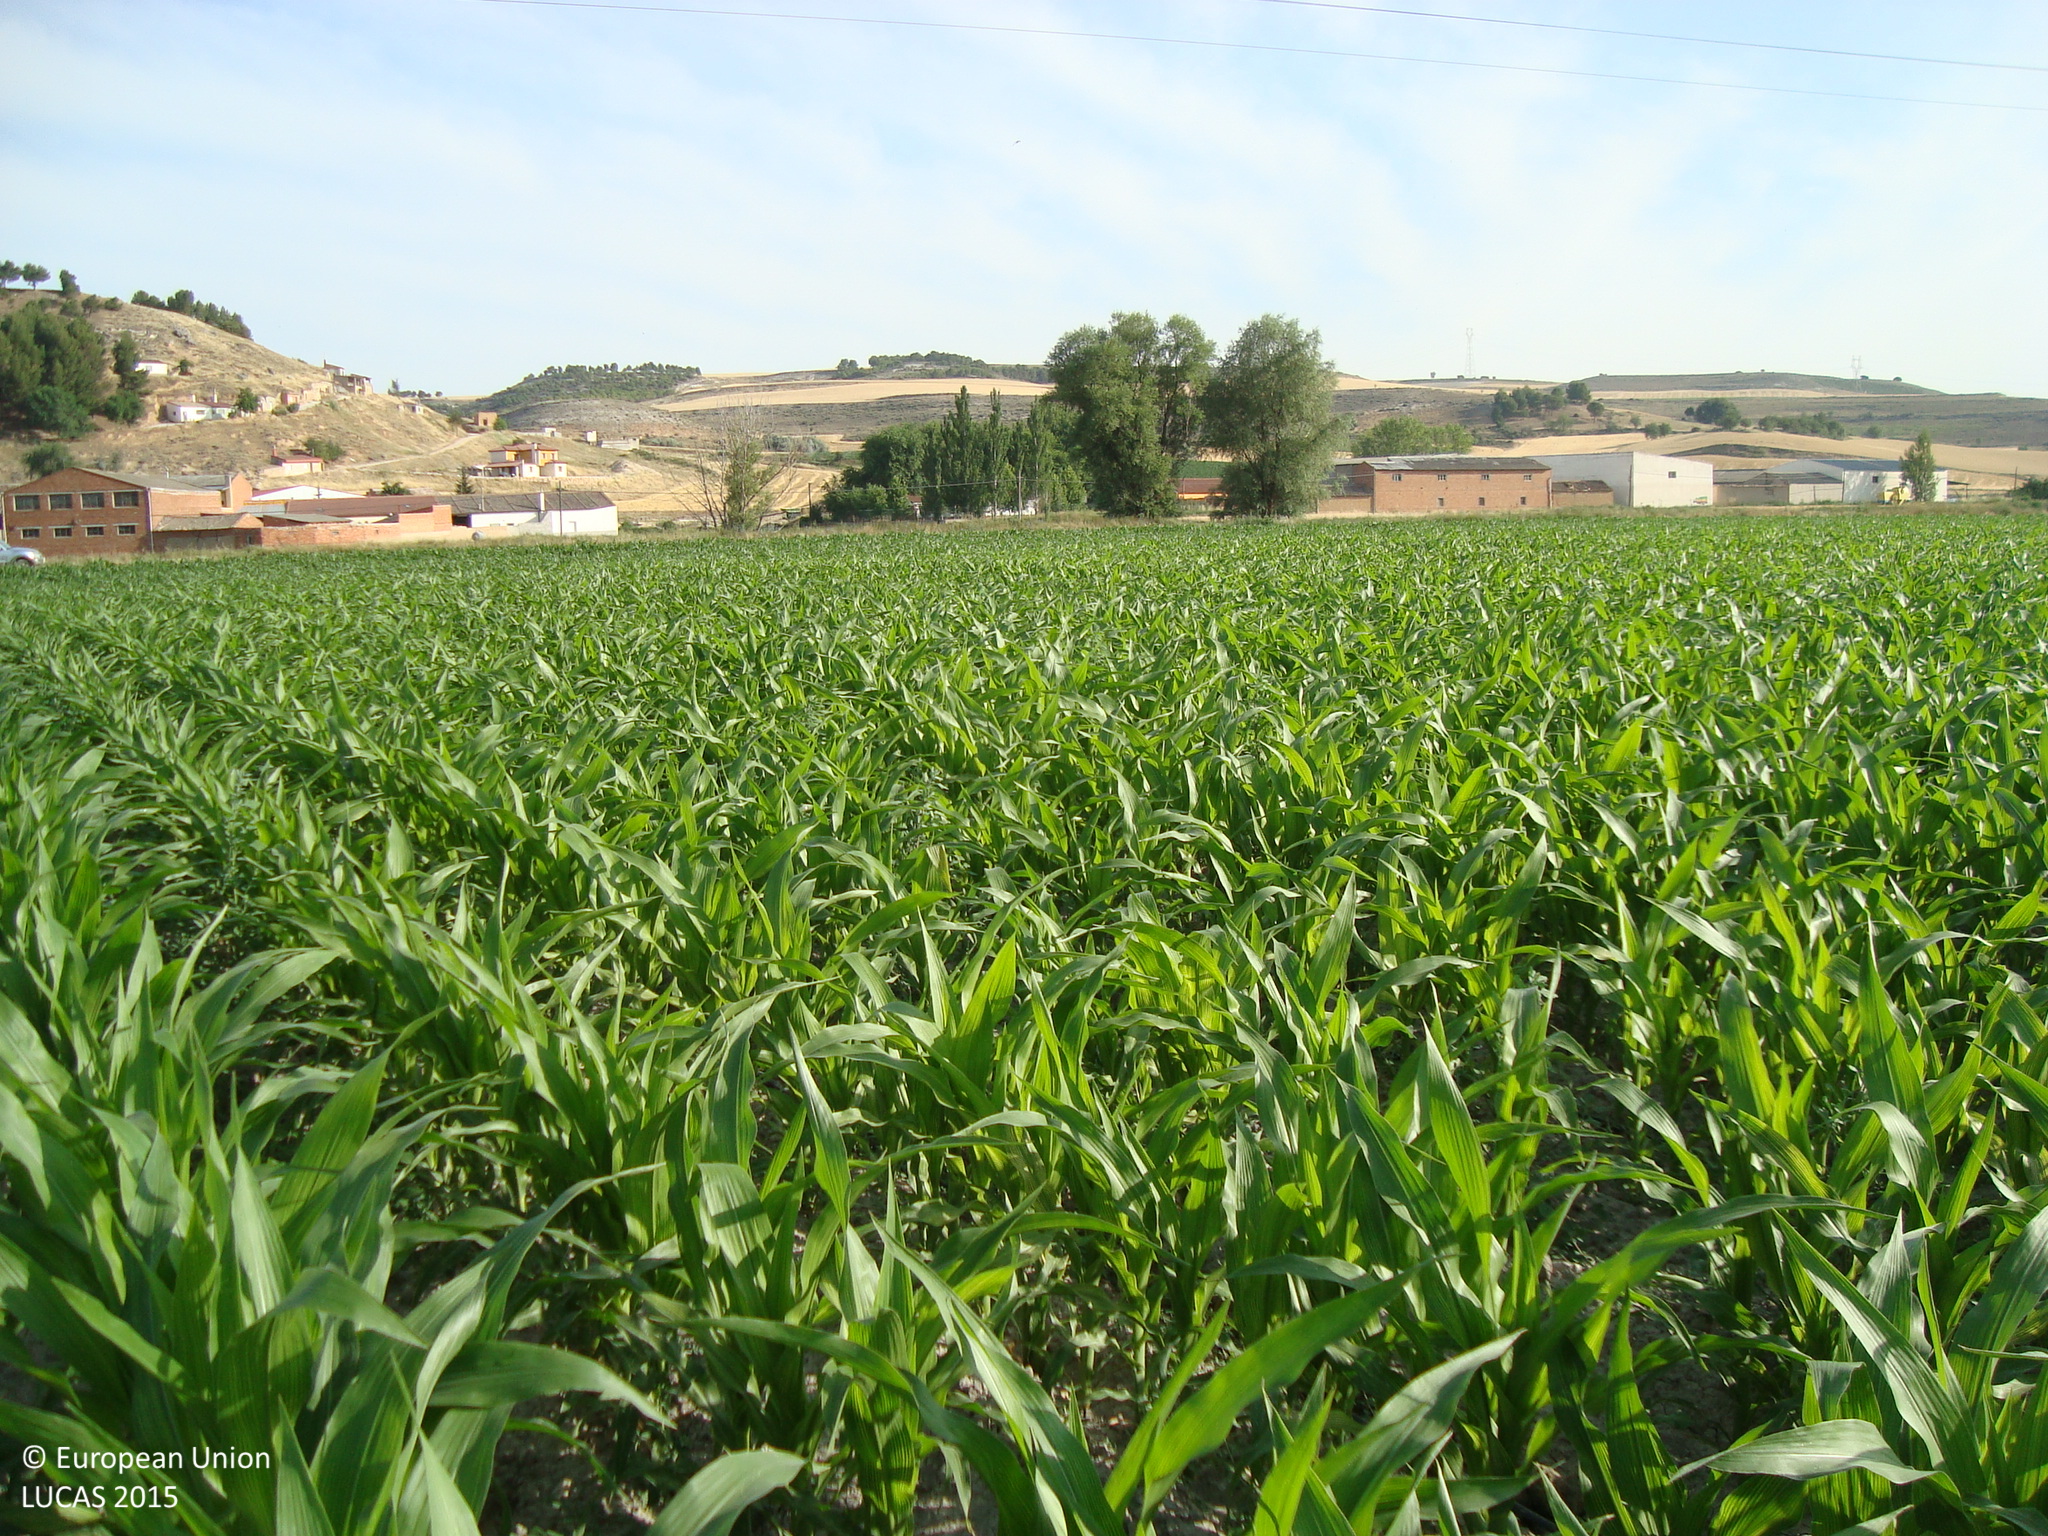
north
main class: Cropland
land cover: Maize
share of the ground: > 75 %
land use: Agriculture (excluding fallow land and kitchen gardens)
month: July
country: ES
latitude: 41.7552
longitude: -4.2174
